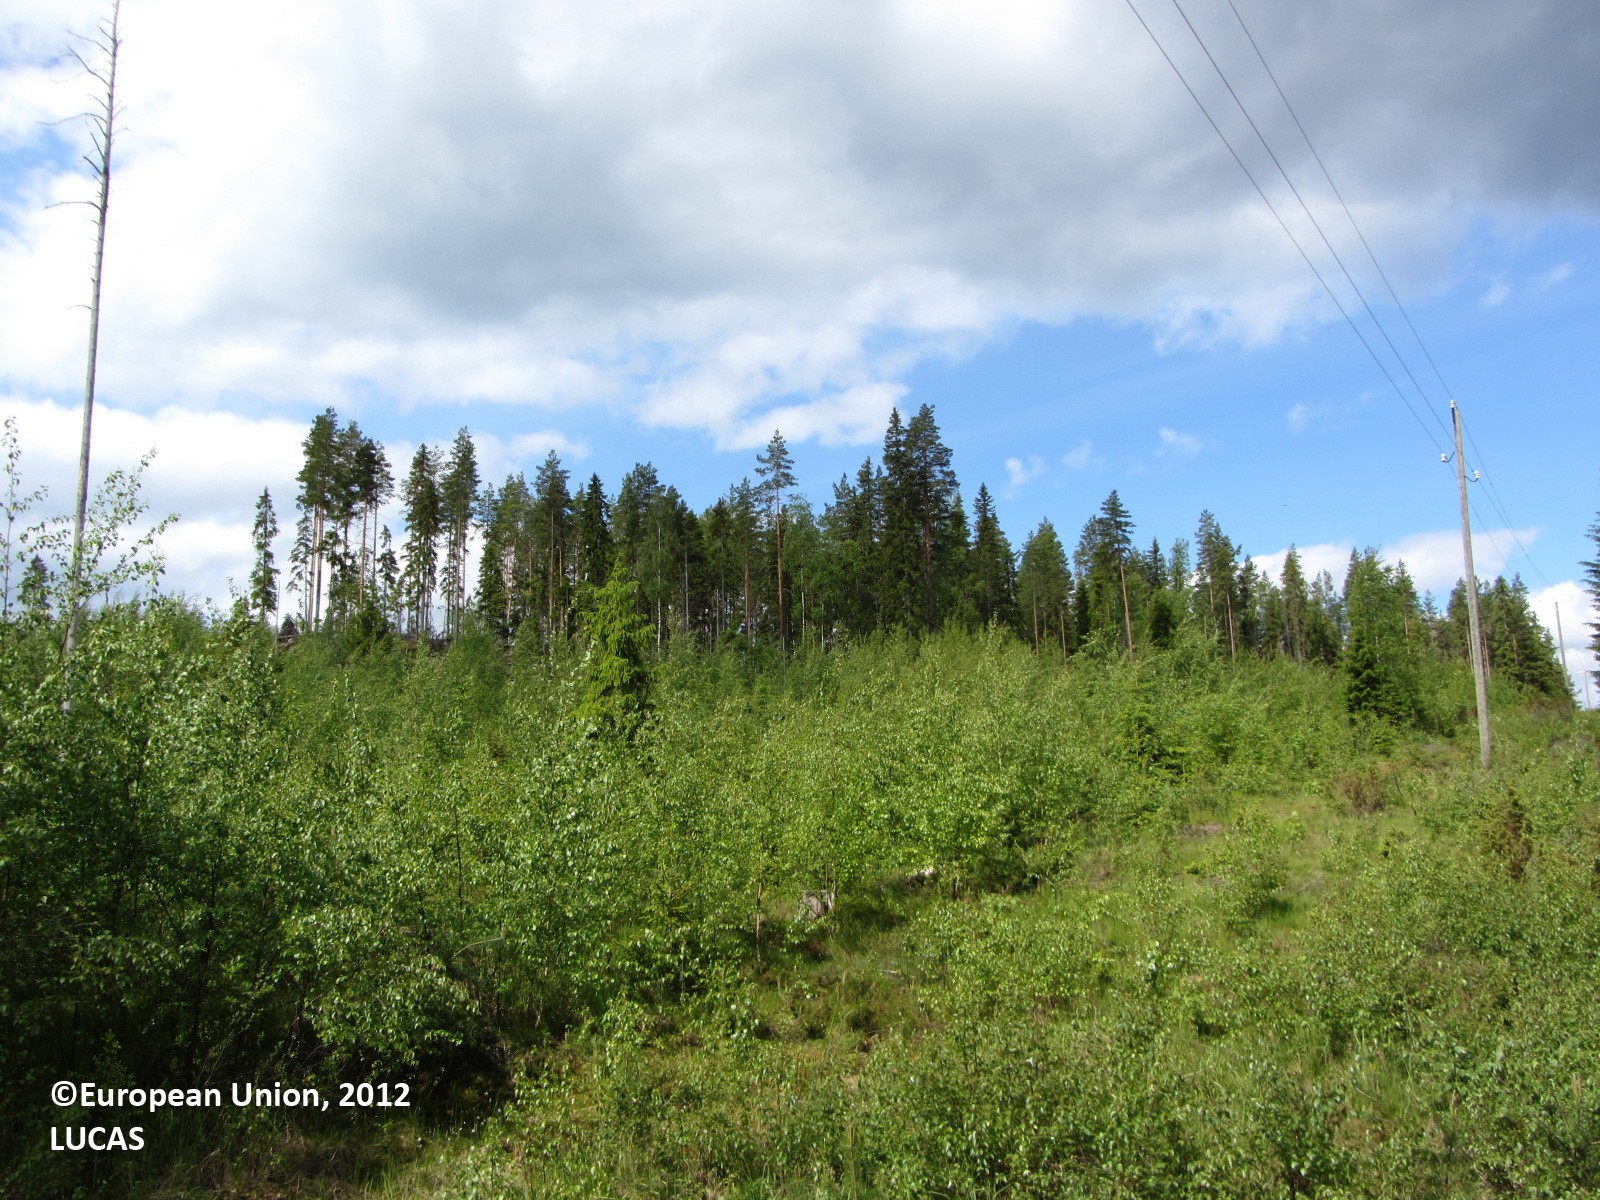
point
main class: Woodland
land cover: Broadleaved woodland
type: boreal forest
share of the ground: > 75 %
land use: Forestry
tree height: > 5 m
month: June
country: FI
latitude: 62.1533
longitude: 24.7793
